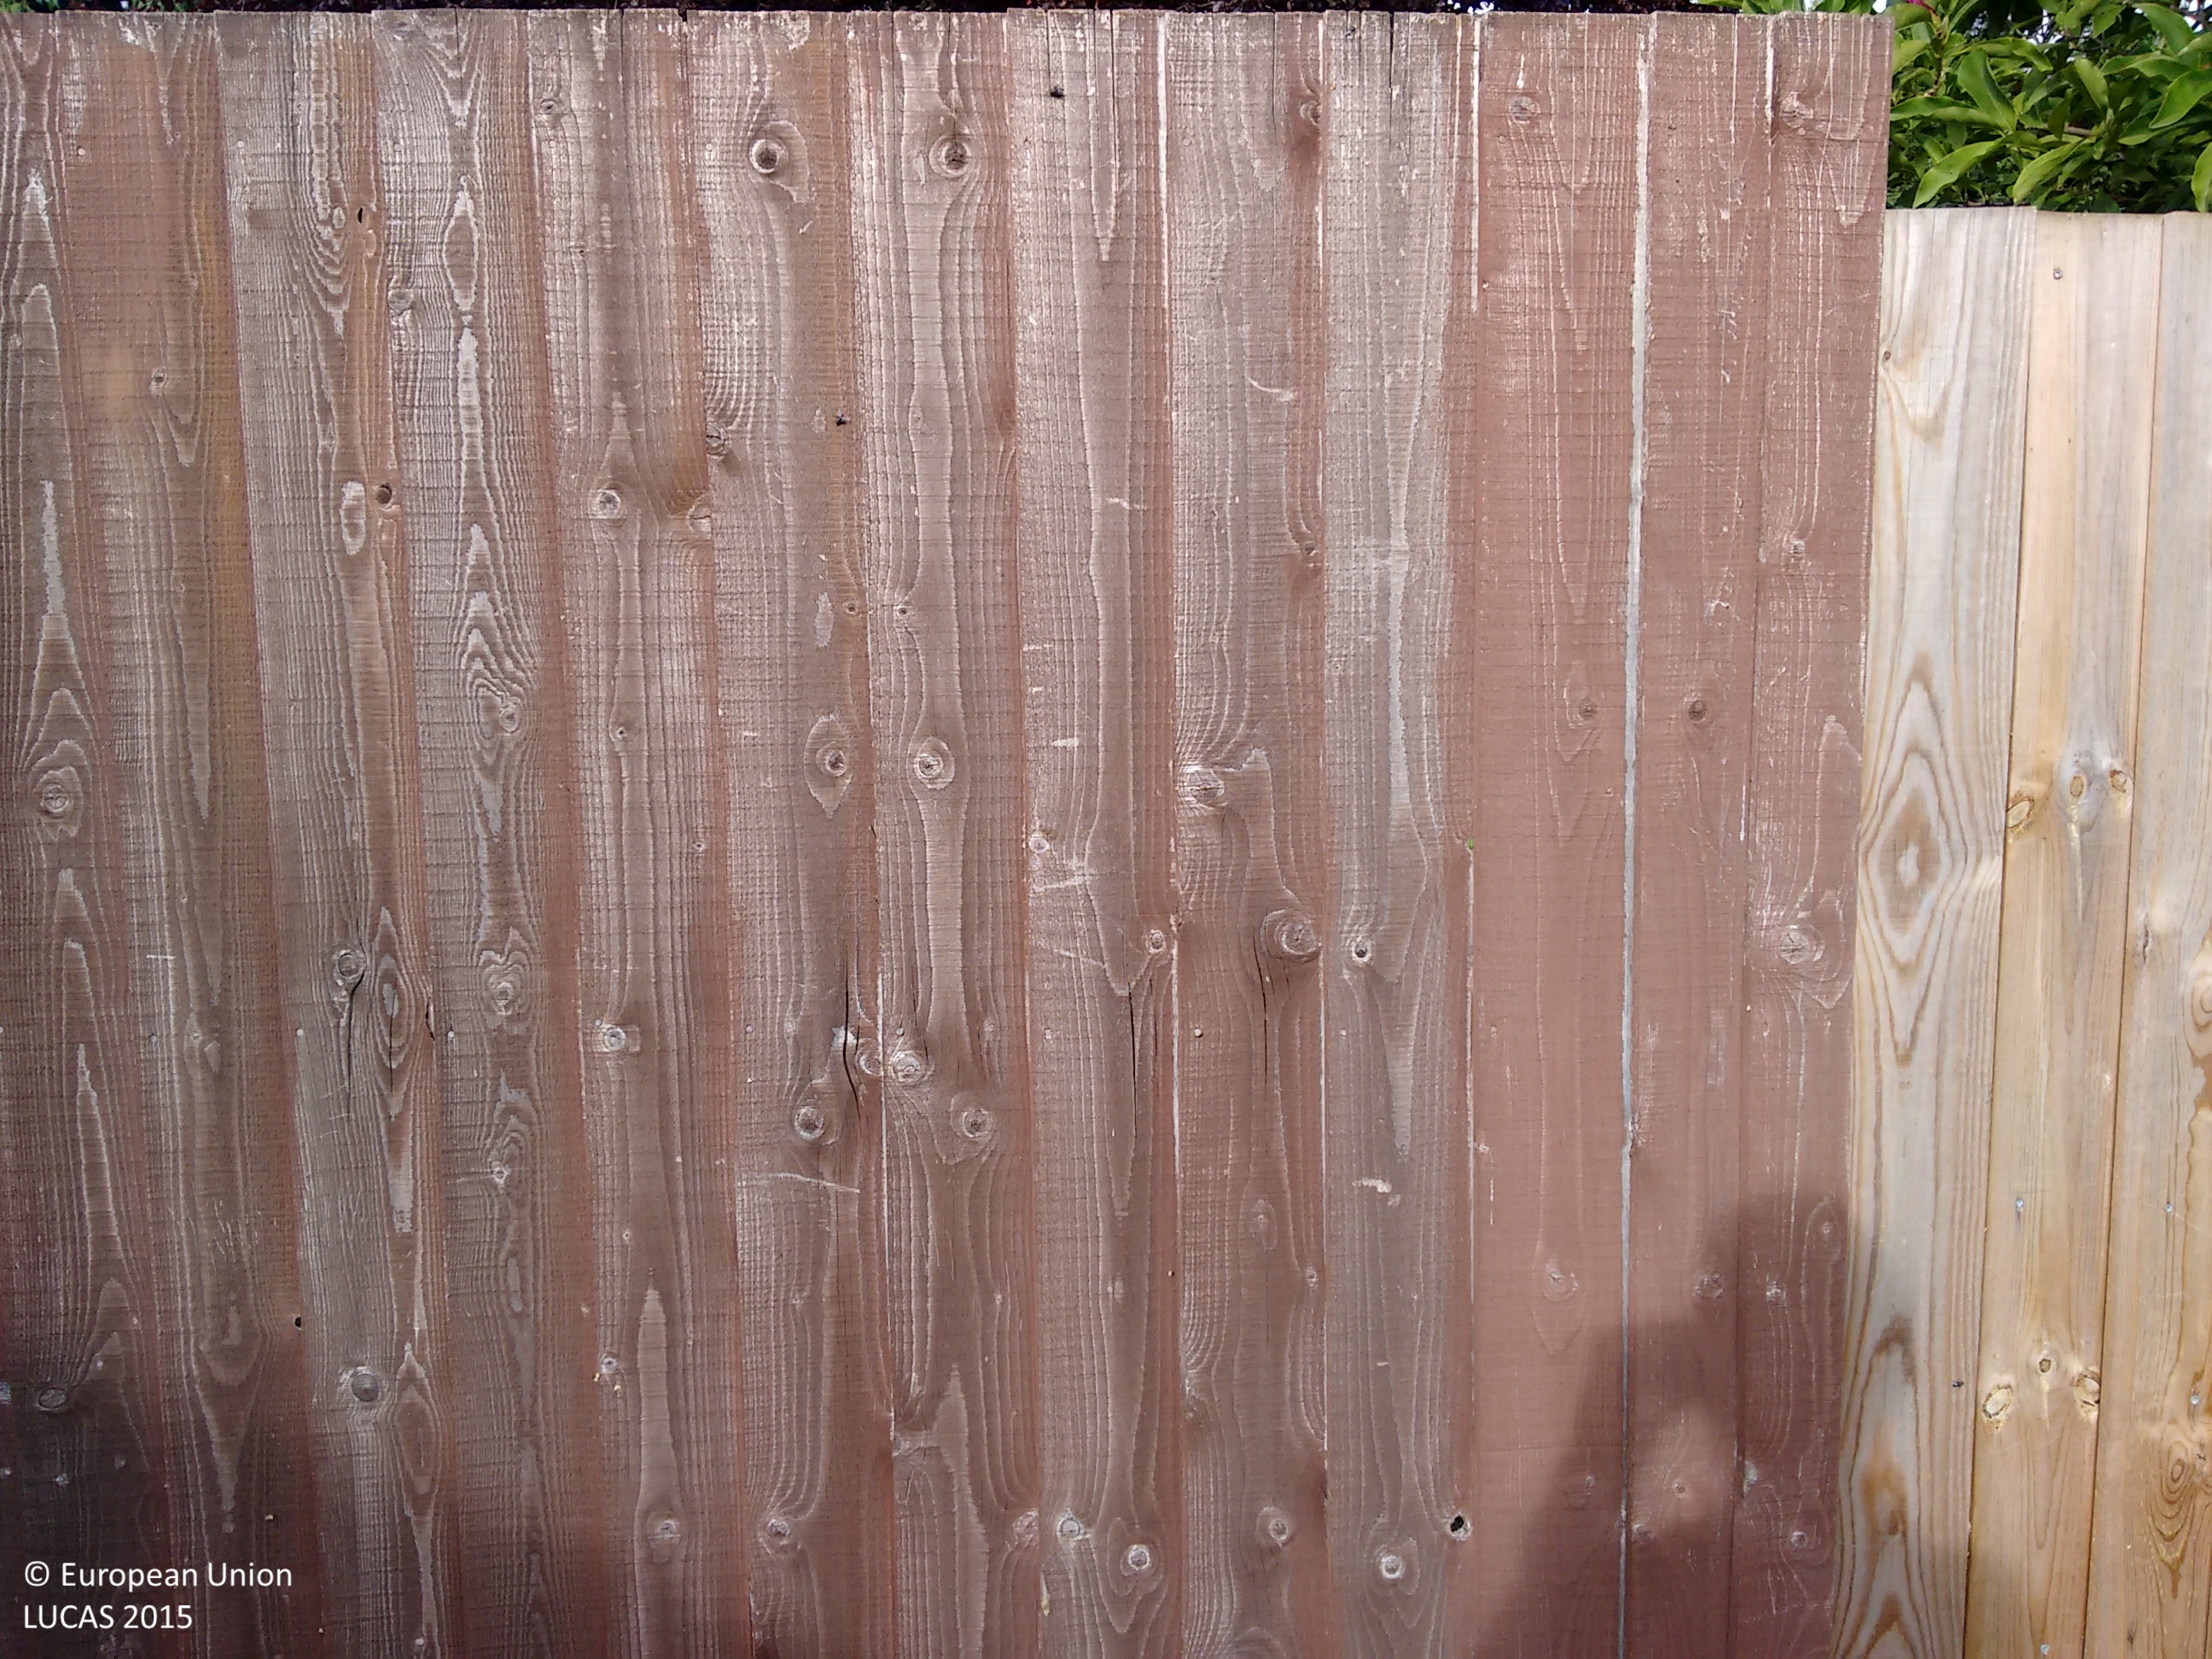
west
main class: Grassland
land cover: Grassland with sparse tree/shrub cover
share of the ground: > 75 %
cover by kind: herbaceous plants 95 %, broadleaved forest trees 5 %
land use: Residential
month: September
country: GB
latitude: 52.6324
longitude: 1.2469
